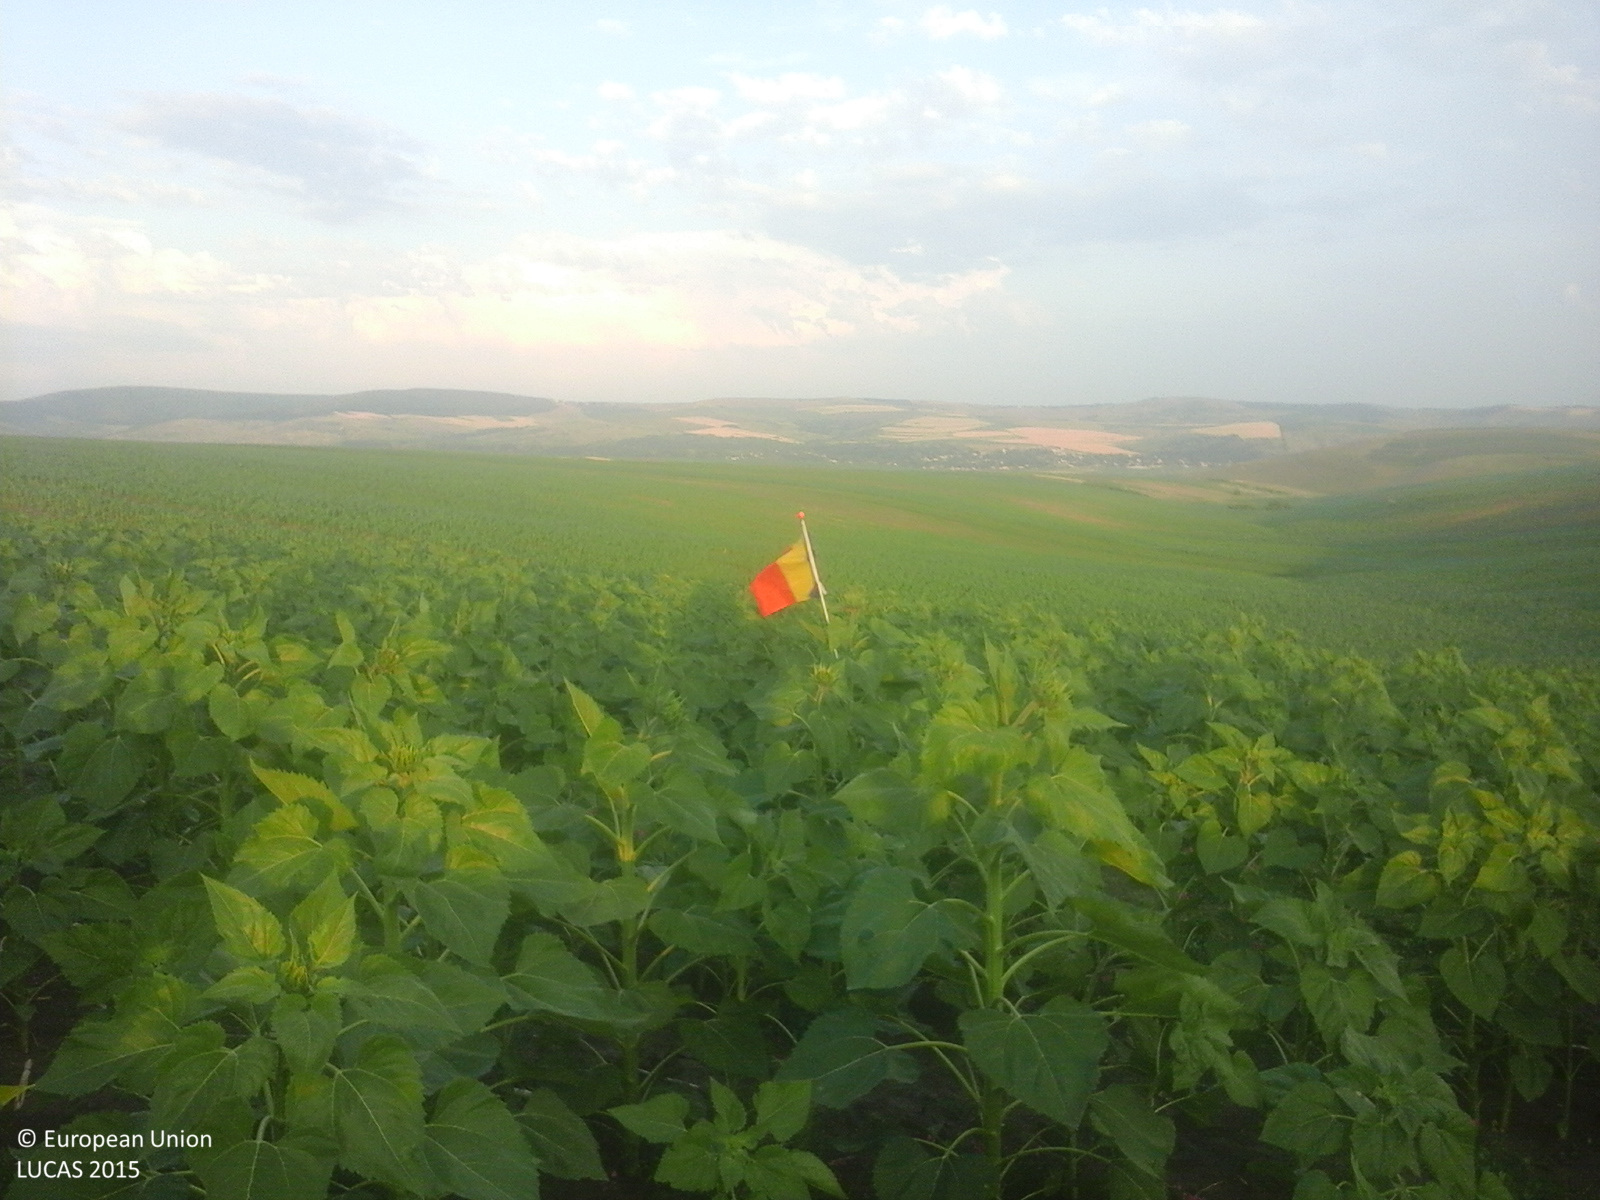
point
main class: Cropland
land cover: Sunflower
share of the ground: > 75 %
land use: Agriculture (excluding fallow land and kitchen gardens)
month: June
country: RO
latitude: 46.7876
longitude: 27.7391
